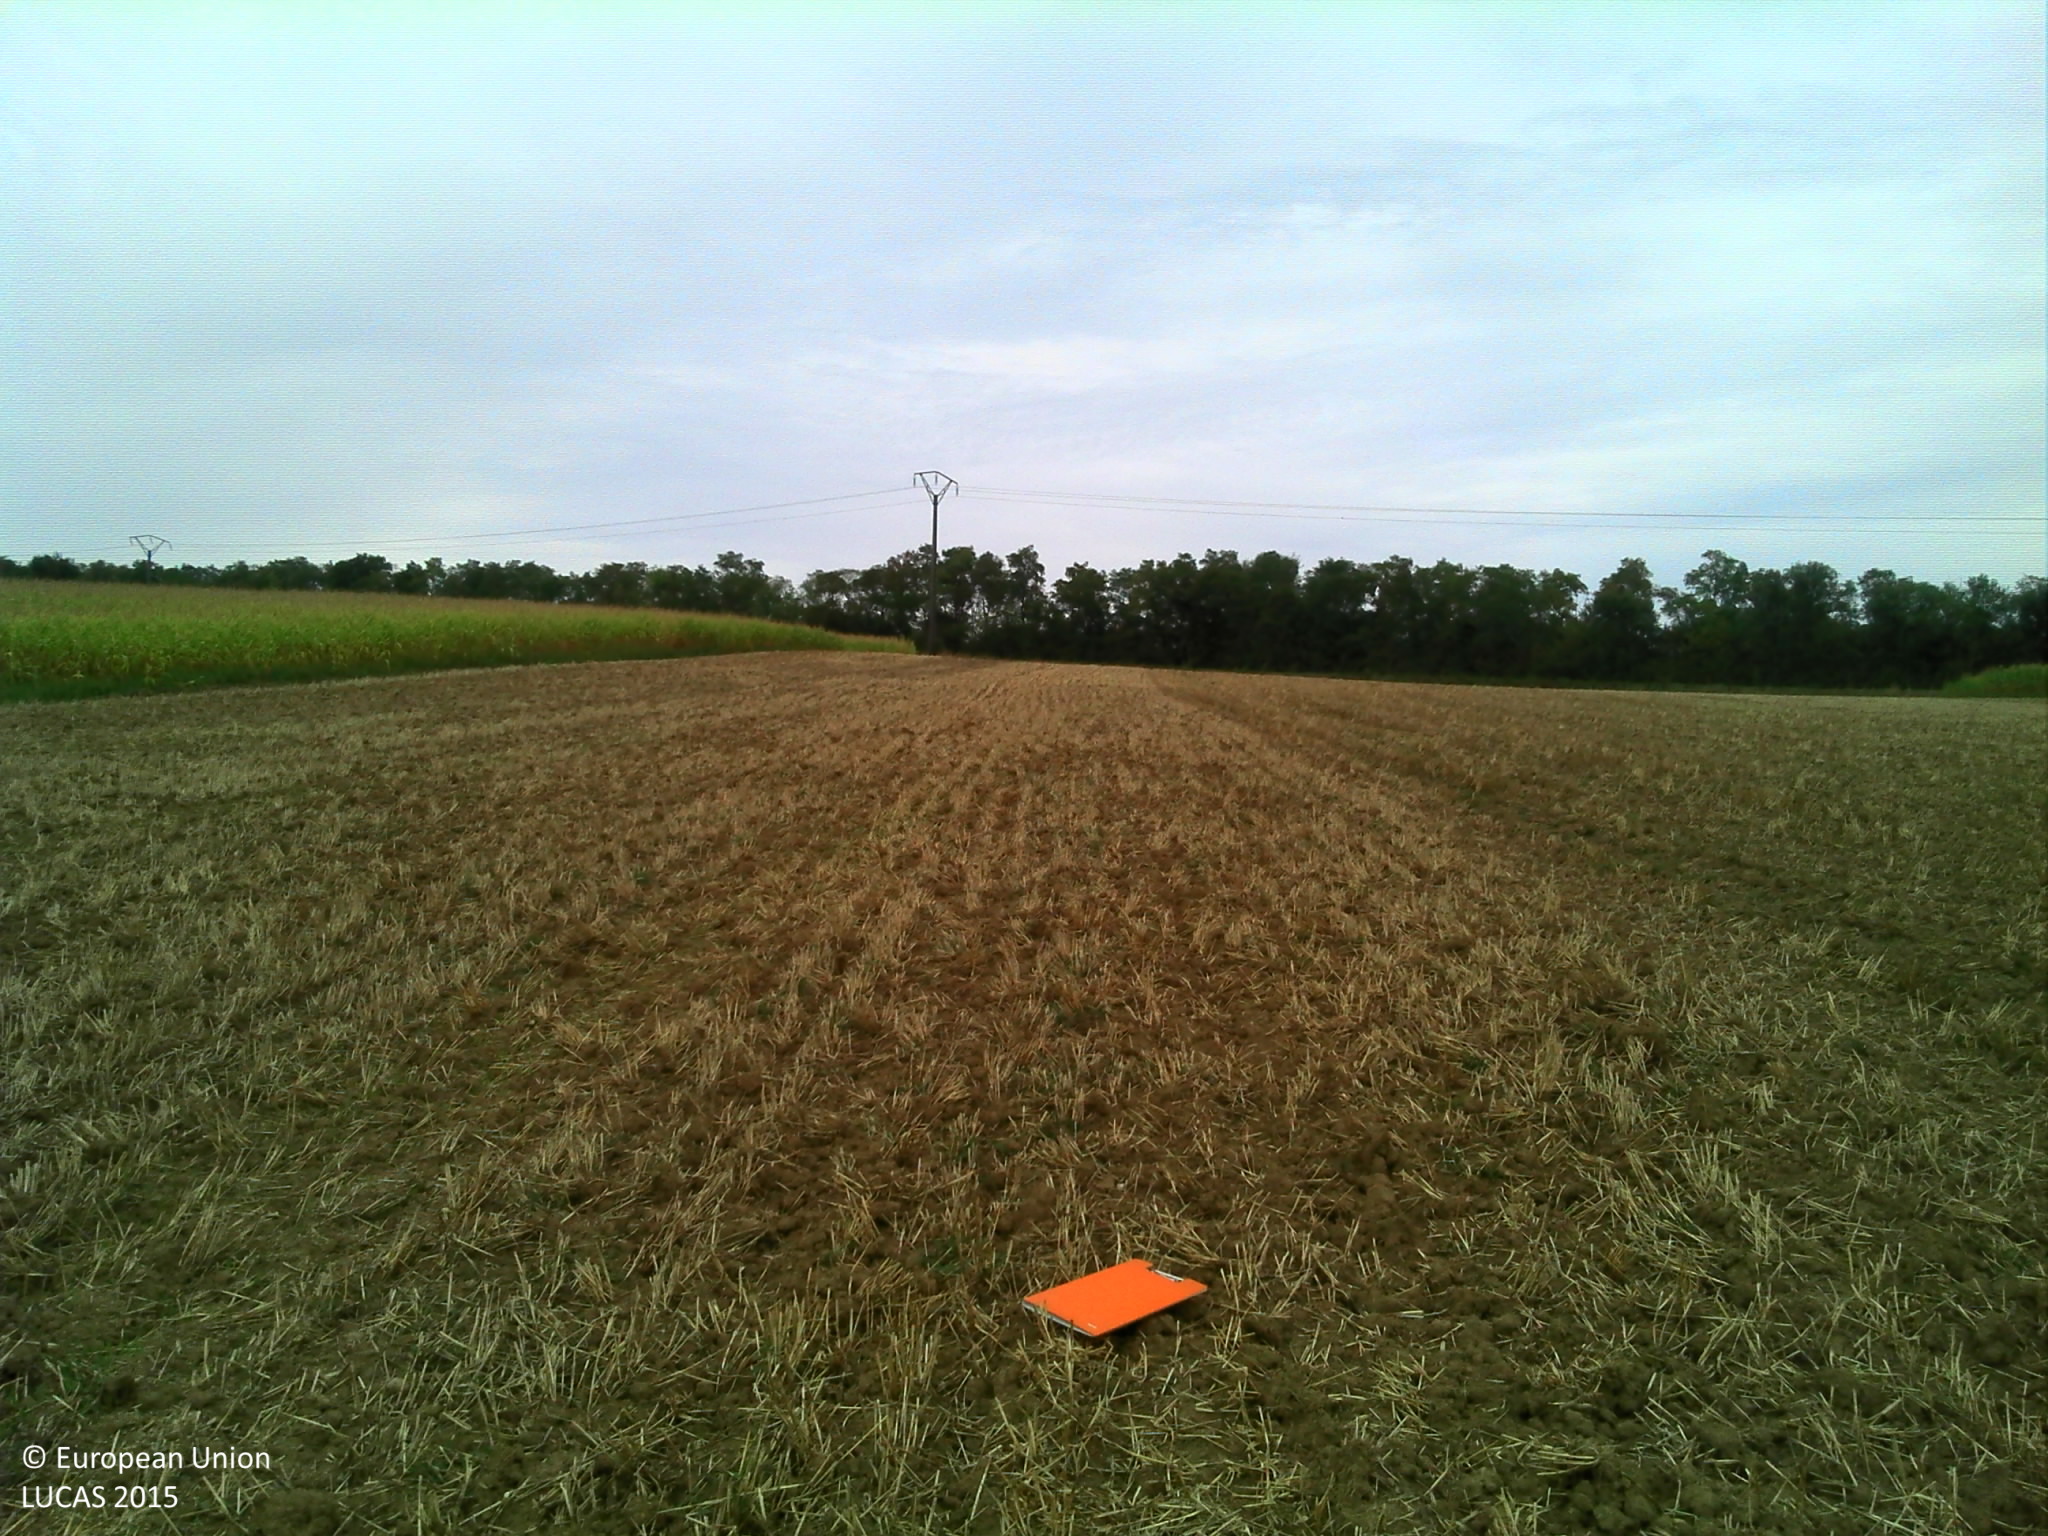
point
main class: Cropland
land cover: Common wheat
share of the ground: 10 - 25 %
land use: Agriculture (excluding fallow land and kitchen gardens)
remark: Harvested field
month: August
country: FR
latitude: 48.9363
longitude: 7.6390
